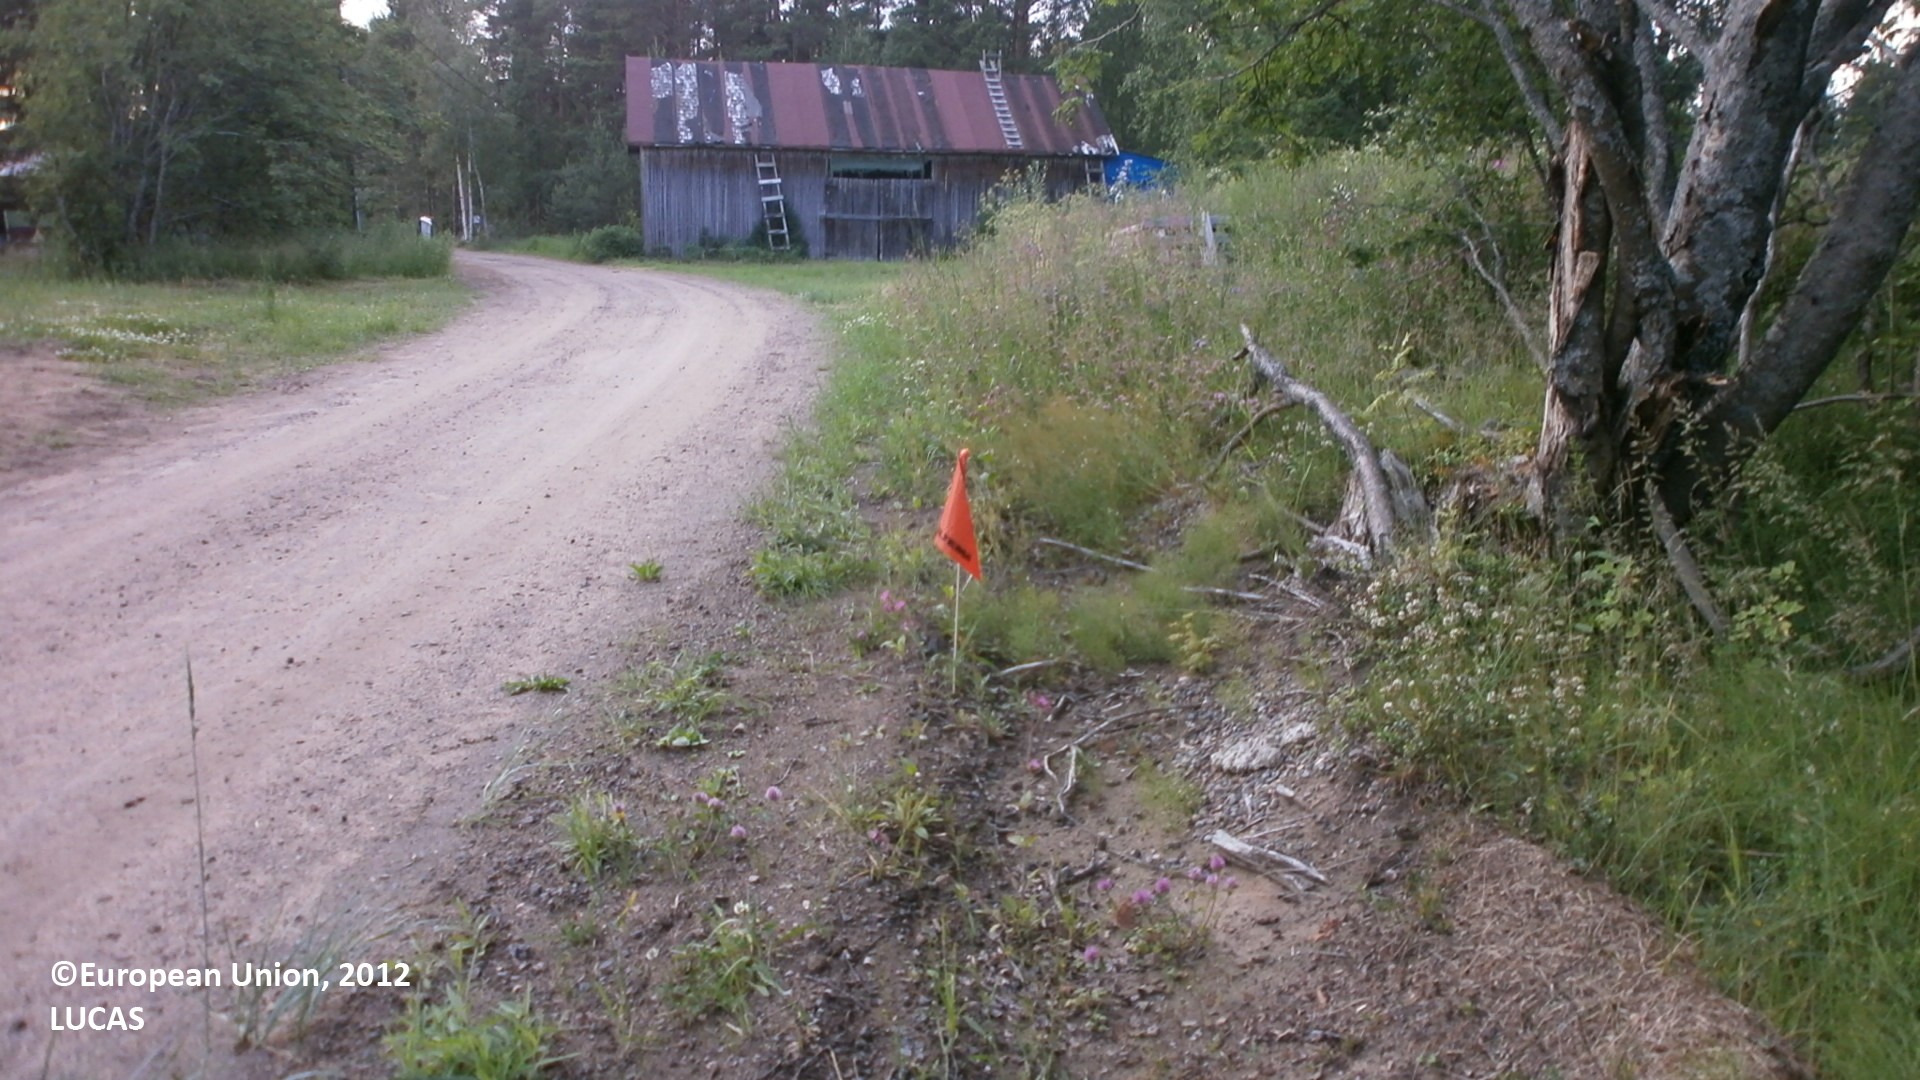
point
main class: Woodland
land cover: Spruce dominated mixed woodland
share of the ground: 50 - 75 %
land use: Residential
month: July
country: FI
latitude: 64.7305
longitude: 24.6186
